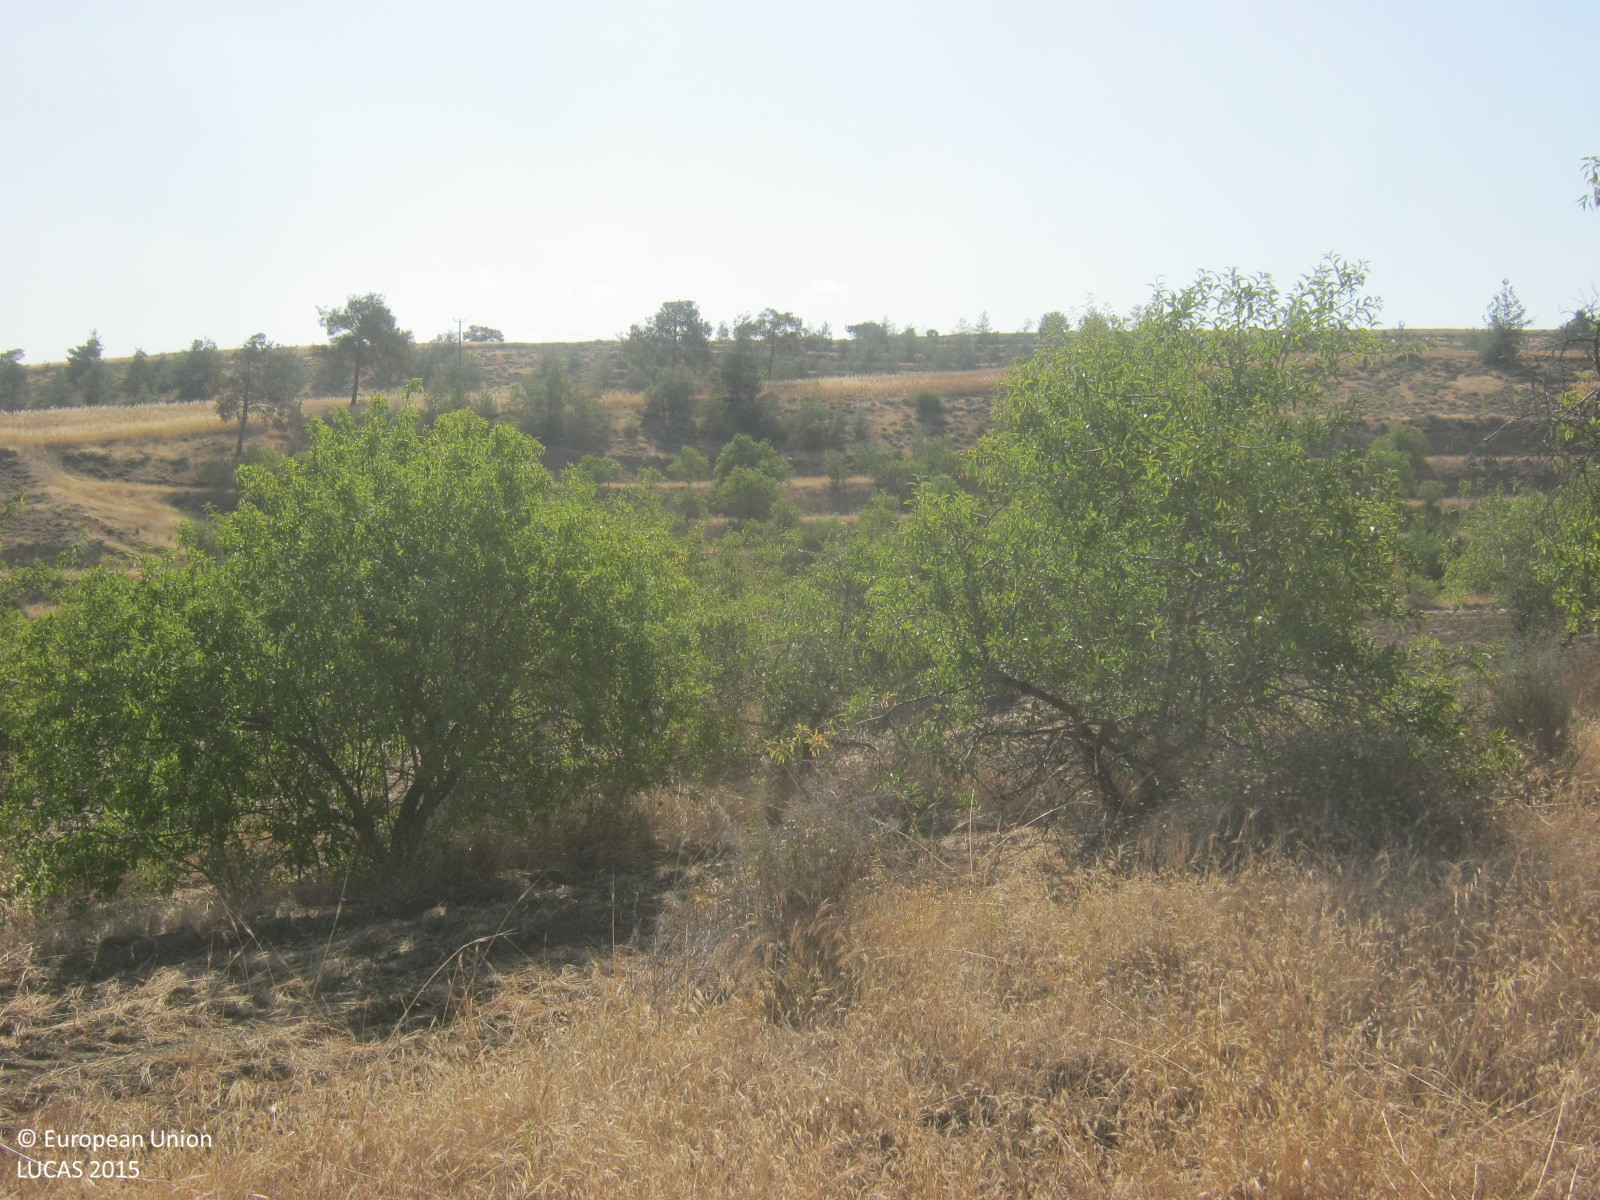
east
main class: Cropland
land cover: Nuts trees
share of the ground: 10 - 25 %
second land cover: Spontaneously vegetated surfaces
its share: > 75 %
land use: Agriculture (excluding fallow land and kitchen gardens)
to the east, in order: Nuts trees; Spontaneously vegetated surfaces; Other bare soil; Grass margins; Other bare soil; Nuts trees; Spontaneously vegetated surfaces; Pine dominated coniferous woodland; Electric lines; Spontaneously vegetated surfaces; Nuts trees; Spontaneously vegetated surfaces
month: May
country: CY
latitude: 35.0757
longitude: 32.9984
